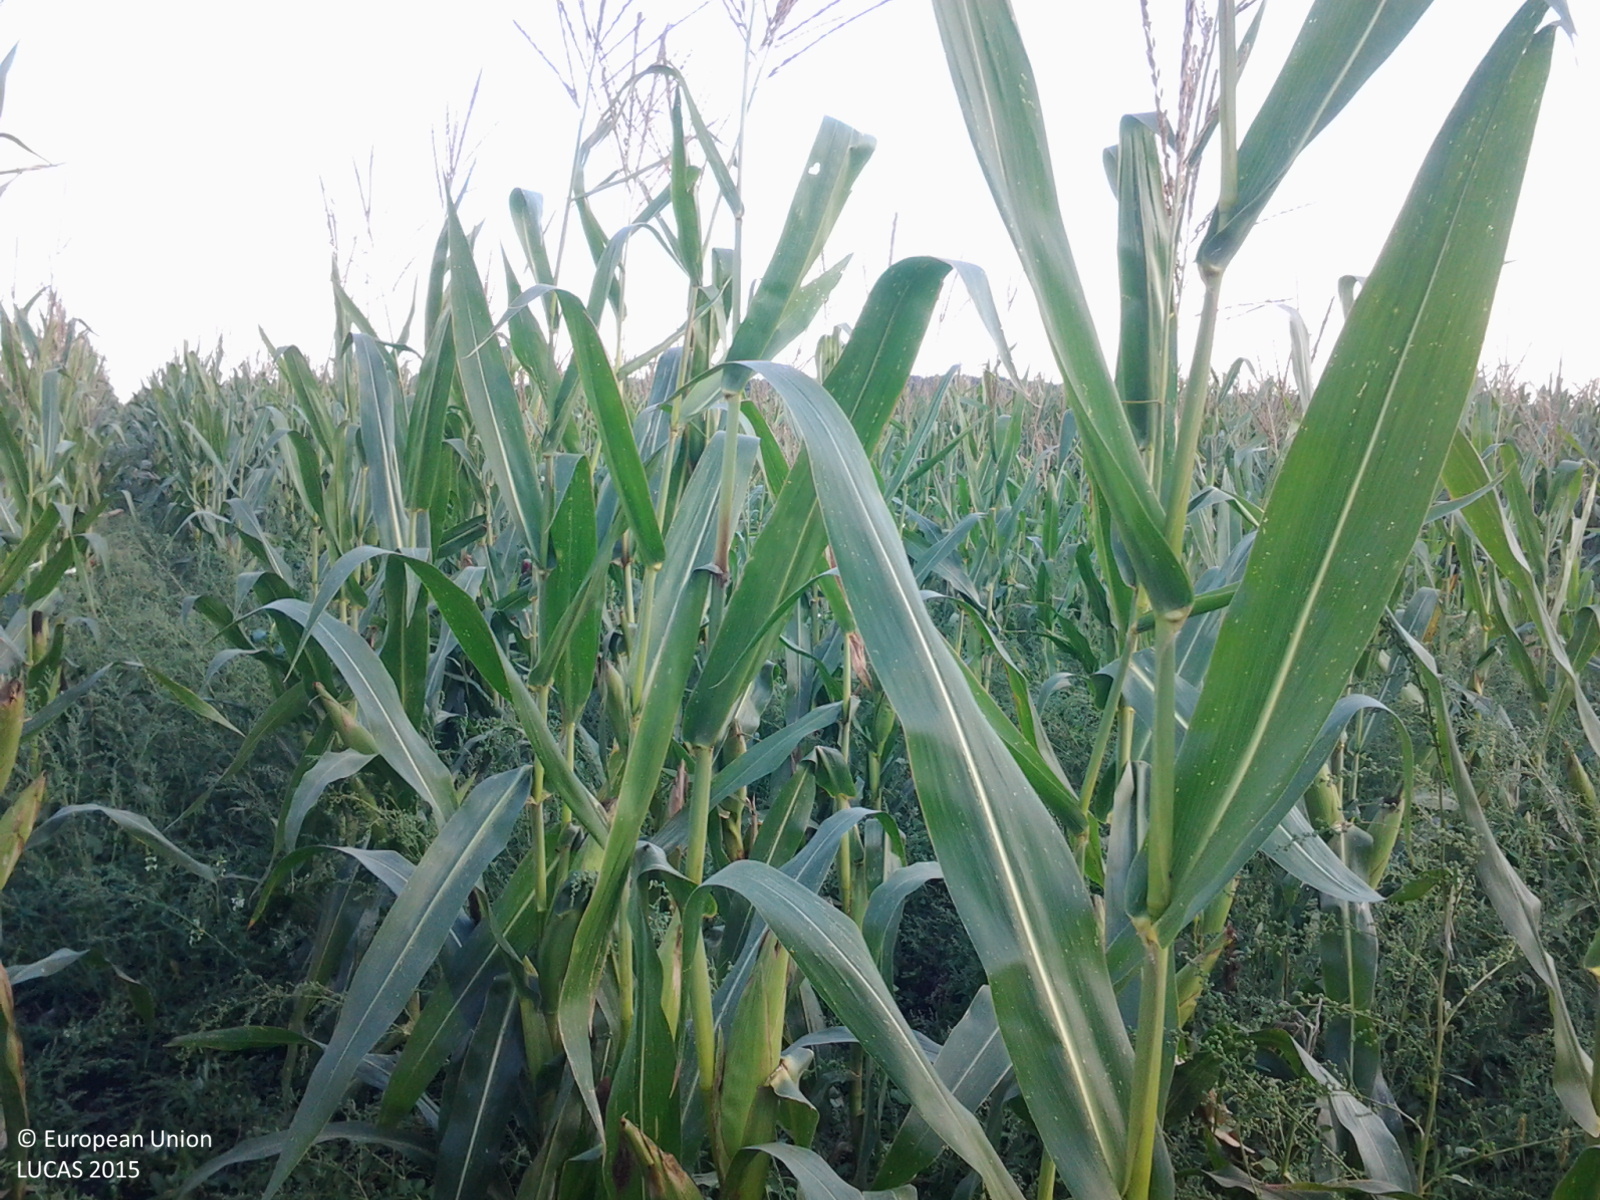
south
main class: Cropland
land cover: Maize
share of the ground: > 75 %
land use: Agriculture (excluding fallow land and kitchen gardens)
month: September
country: HU
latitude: 47.5632
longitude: 20.2496
